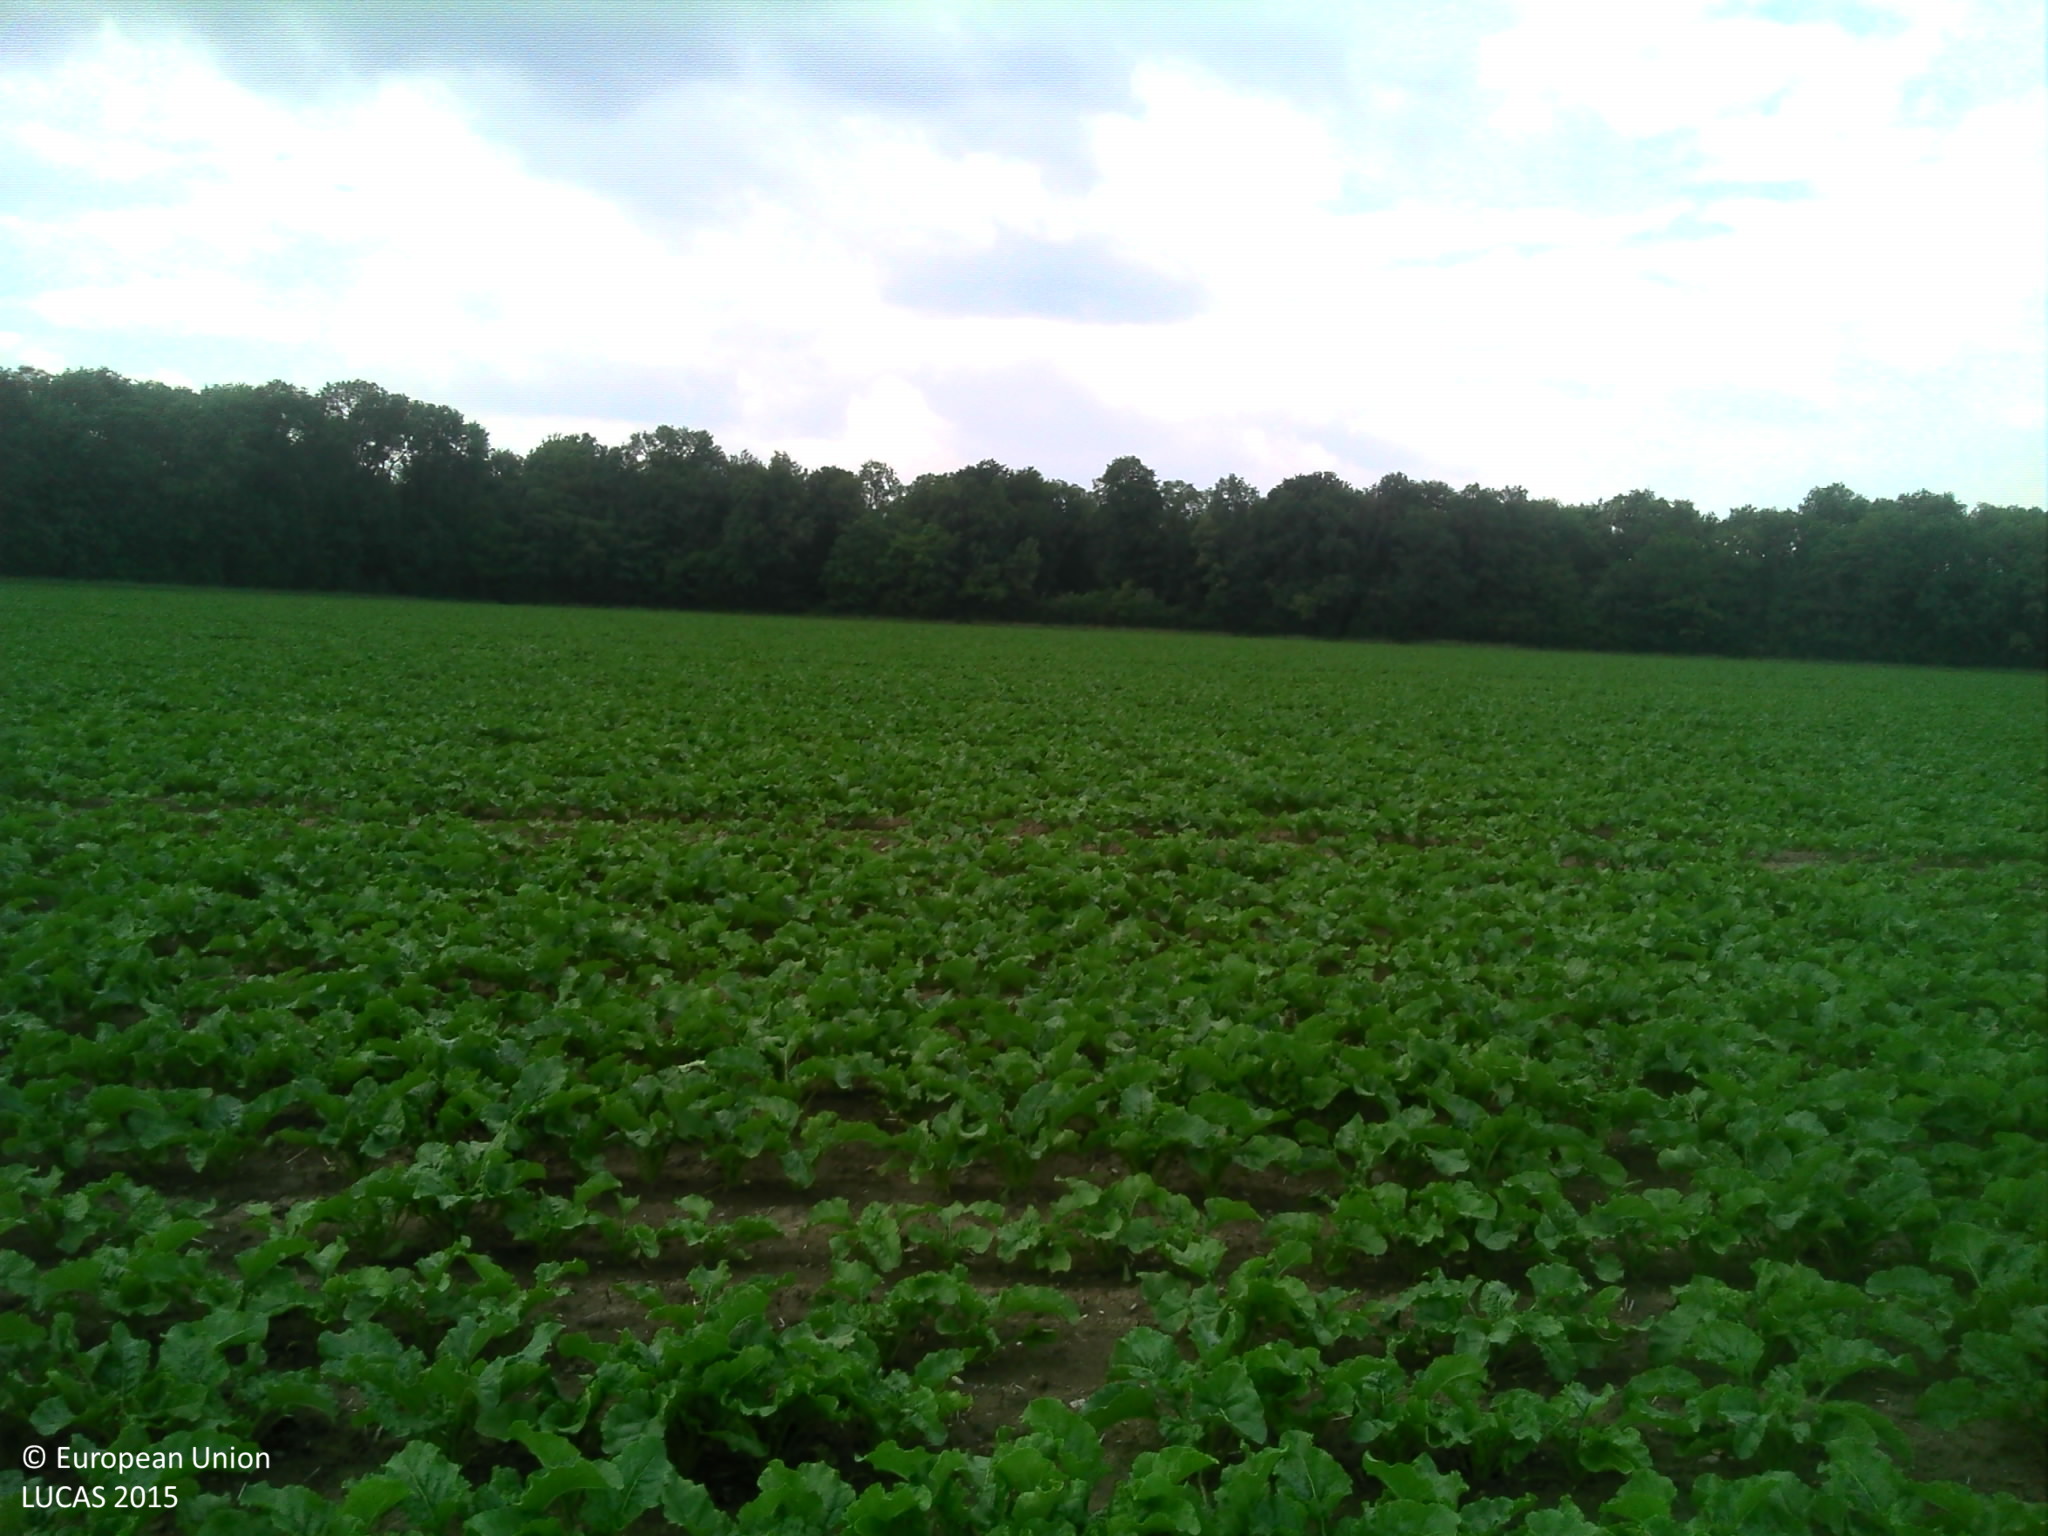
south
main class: Cropland
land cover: Sugar beet
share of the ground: > 75 %
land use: Agriculture (excluding fallow land and kitchen gardens)
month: May
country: FR
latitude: 48.1973
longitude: 7.5928
